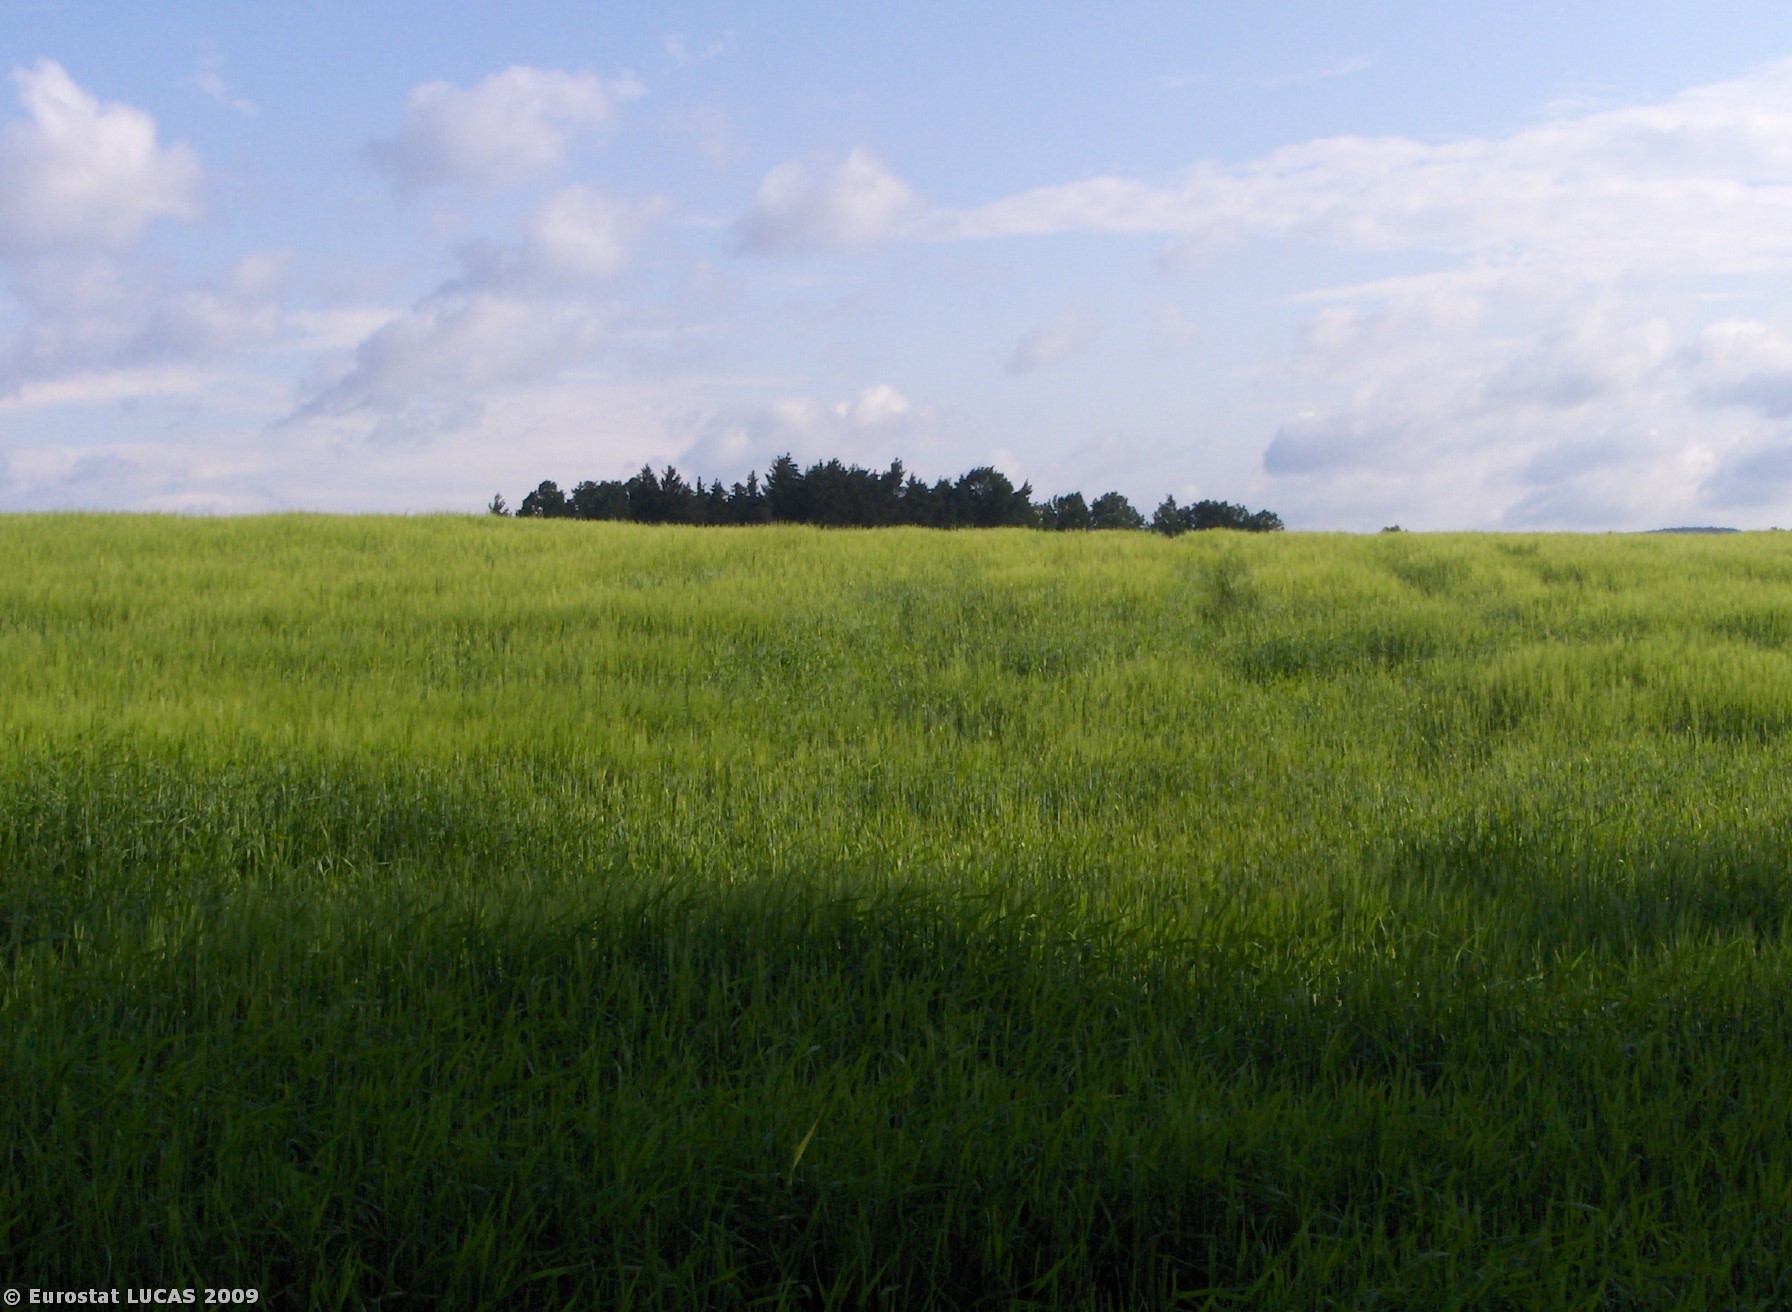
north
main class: Cropland
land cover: Barley
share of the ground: > 75 %
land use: Agriculture (excluding fallow land and kitchen gardens)
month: June
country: CZ
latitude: 49.1658
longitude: 14.3211
